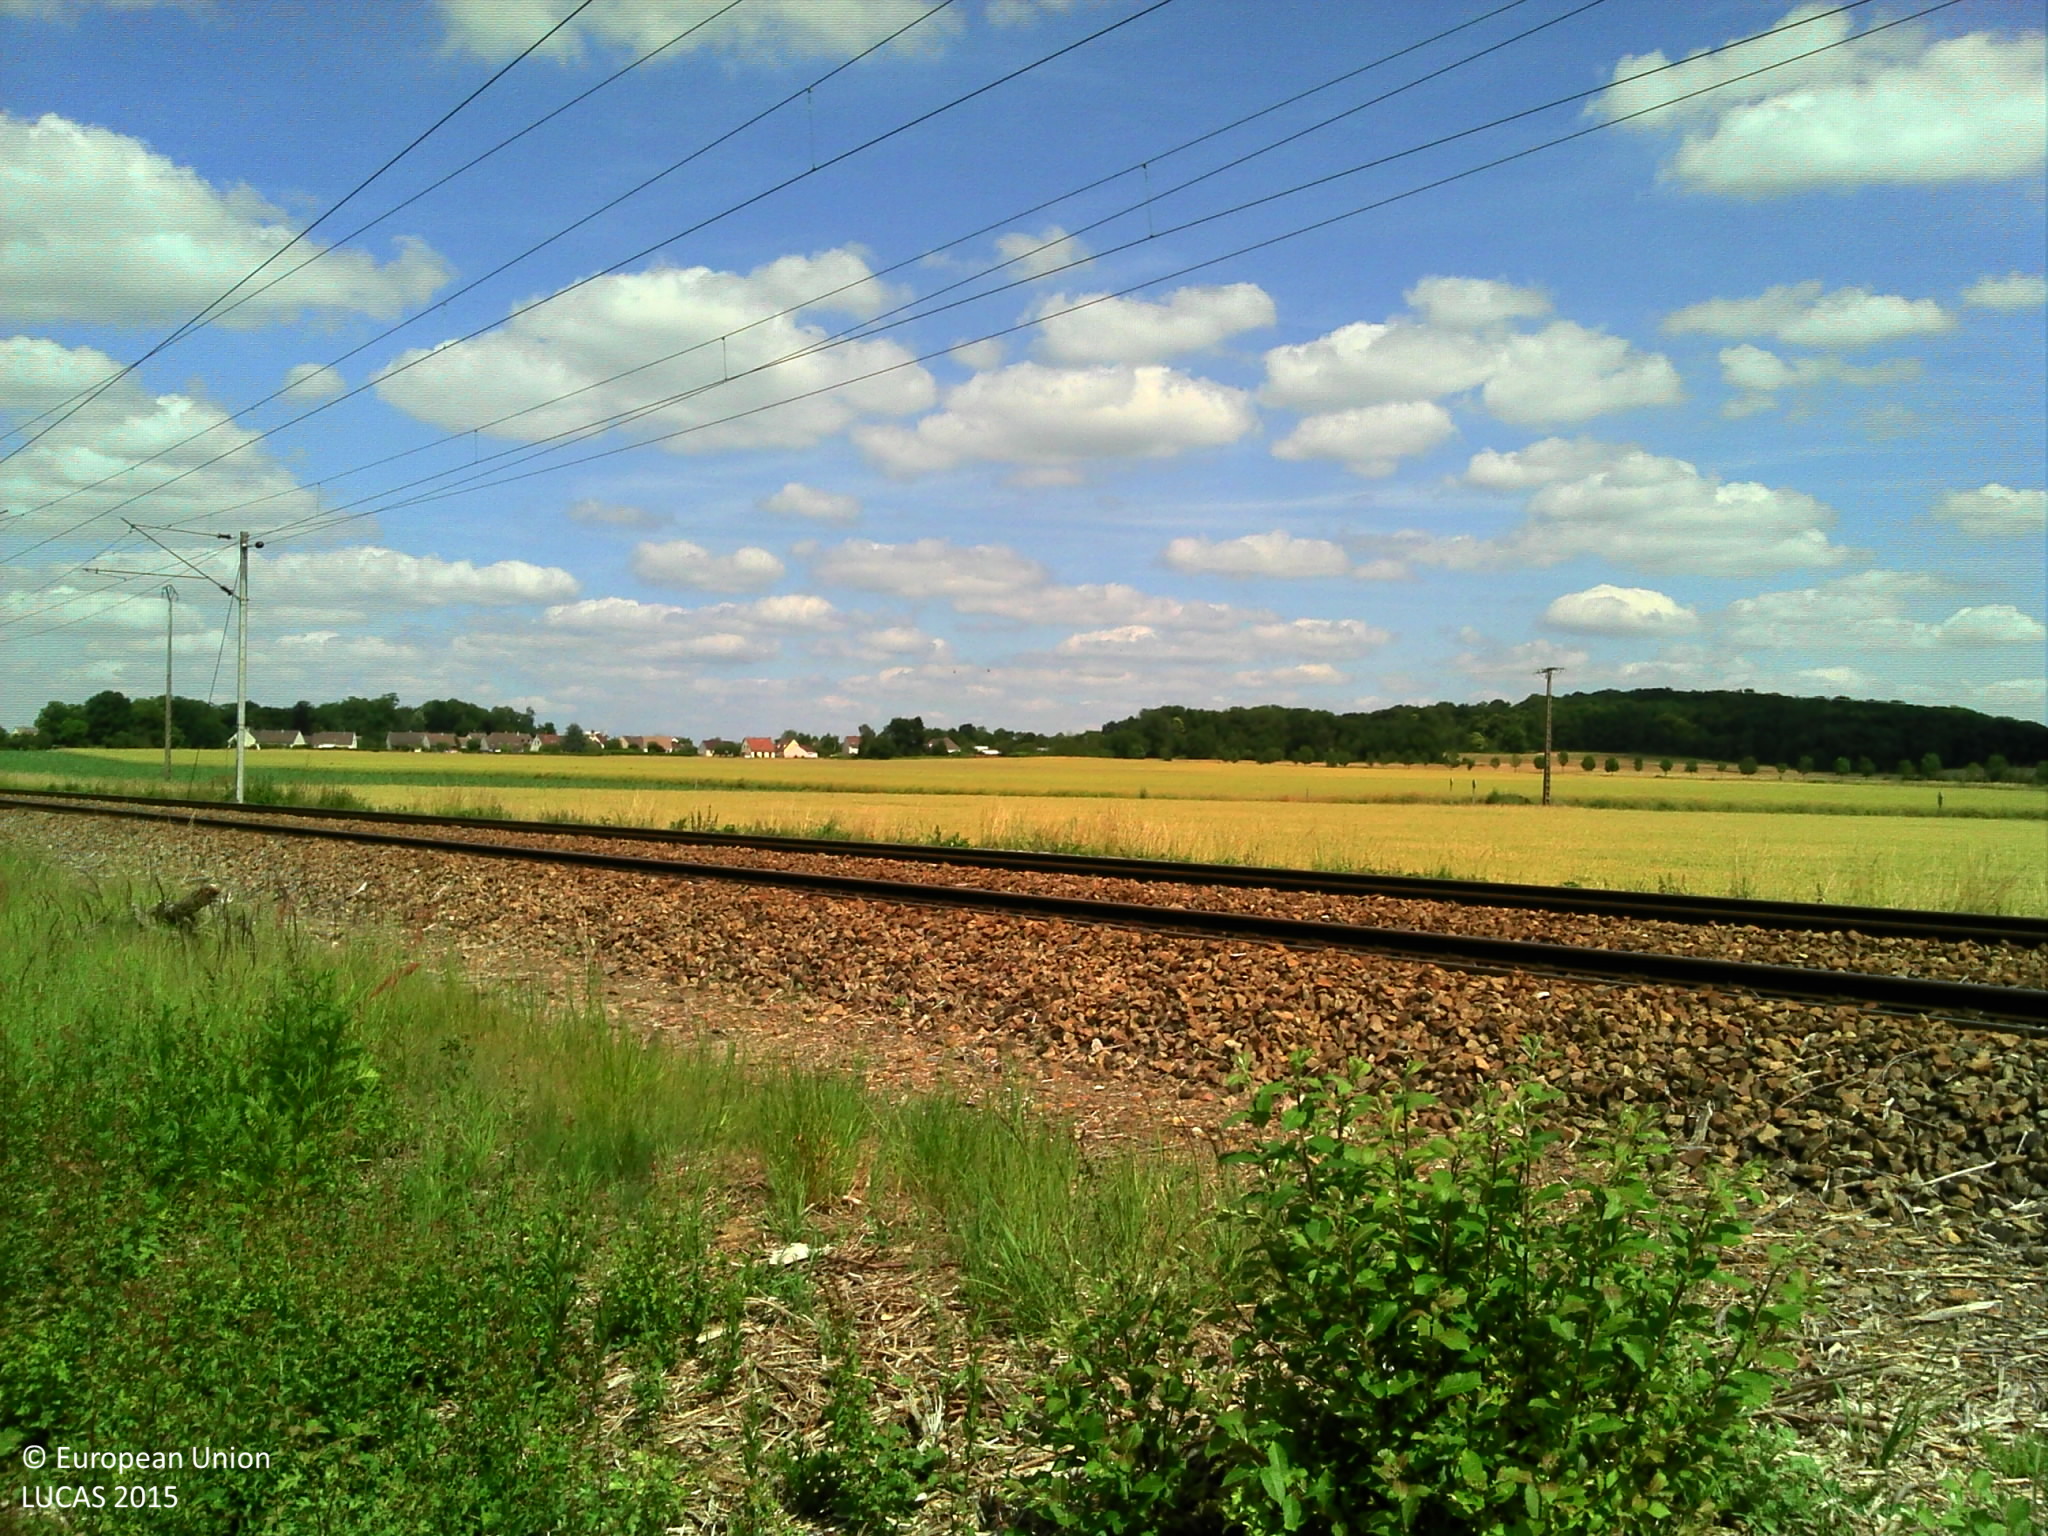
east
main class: Grassland
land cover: Spontaneously vegetated surfaces
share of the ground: > 75 %
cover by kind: herbaceous plants 85 %, unconsolidated bare surface 10 %, shrubs 5 %
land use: Semi-natural and natural areas not in use
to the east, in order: Spontaneously vegetated surfaces; Electric lines; Railways; Electric lines; Grass margins; Ditches and canals; Common wheat; Grass margins; Paved roads, cycling and walking lanes; Electric lines; Grass margins; Rape and turnip rape
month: June
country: FR
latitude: 49.2203
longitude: 2.8645
